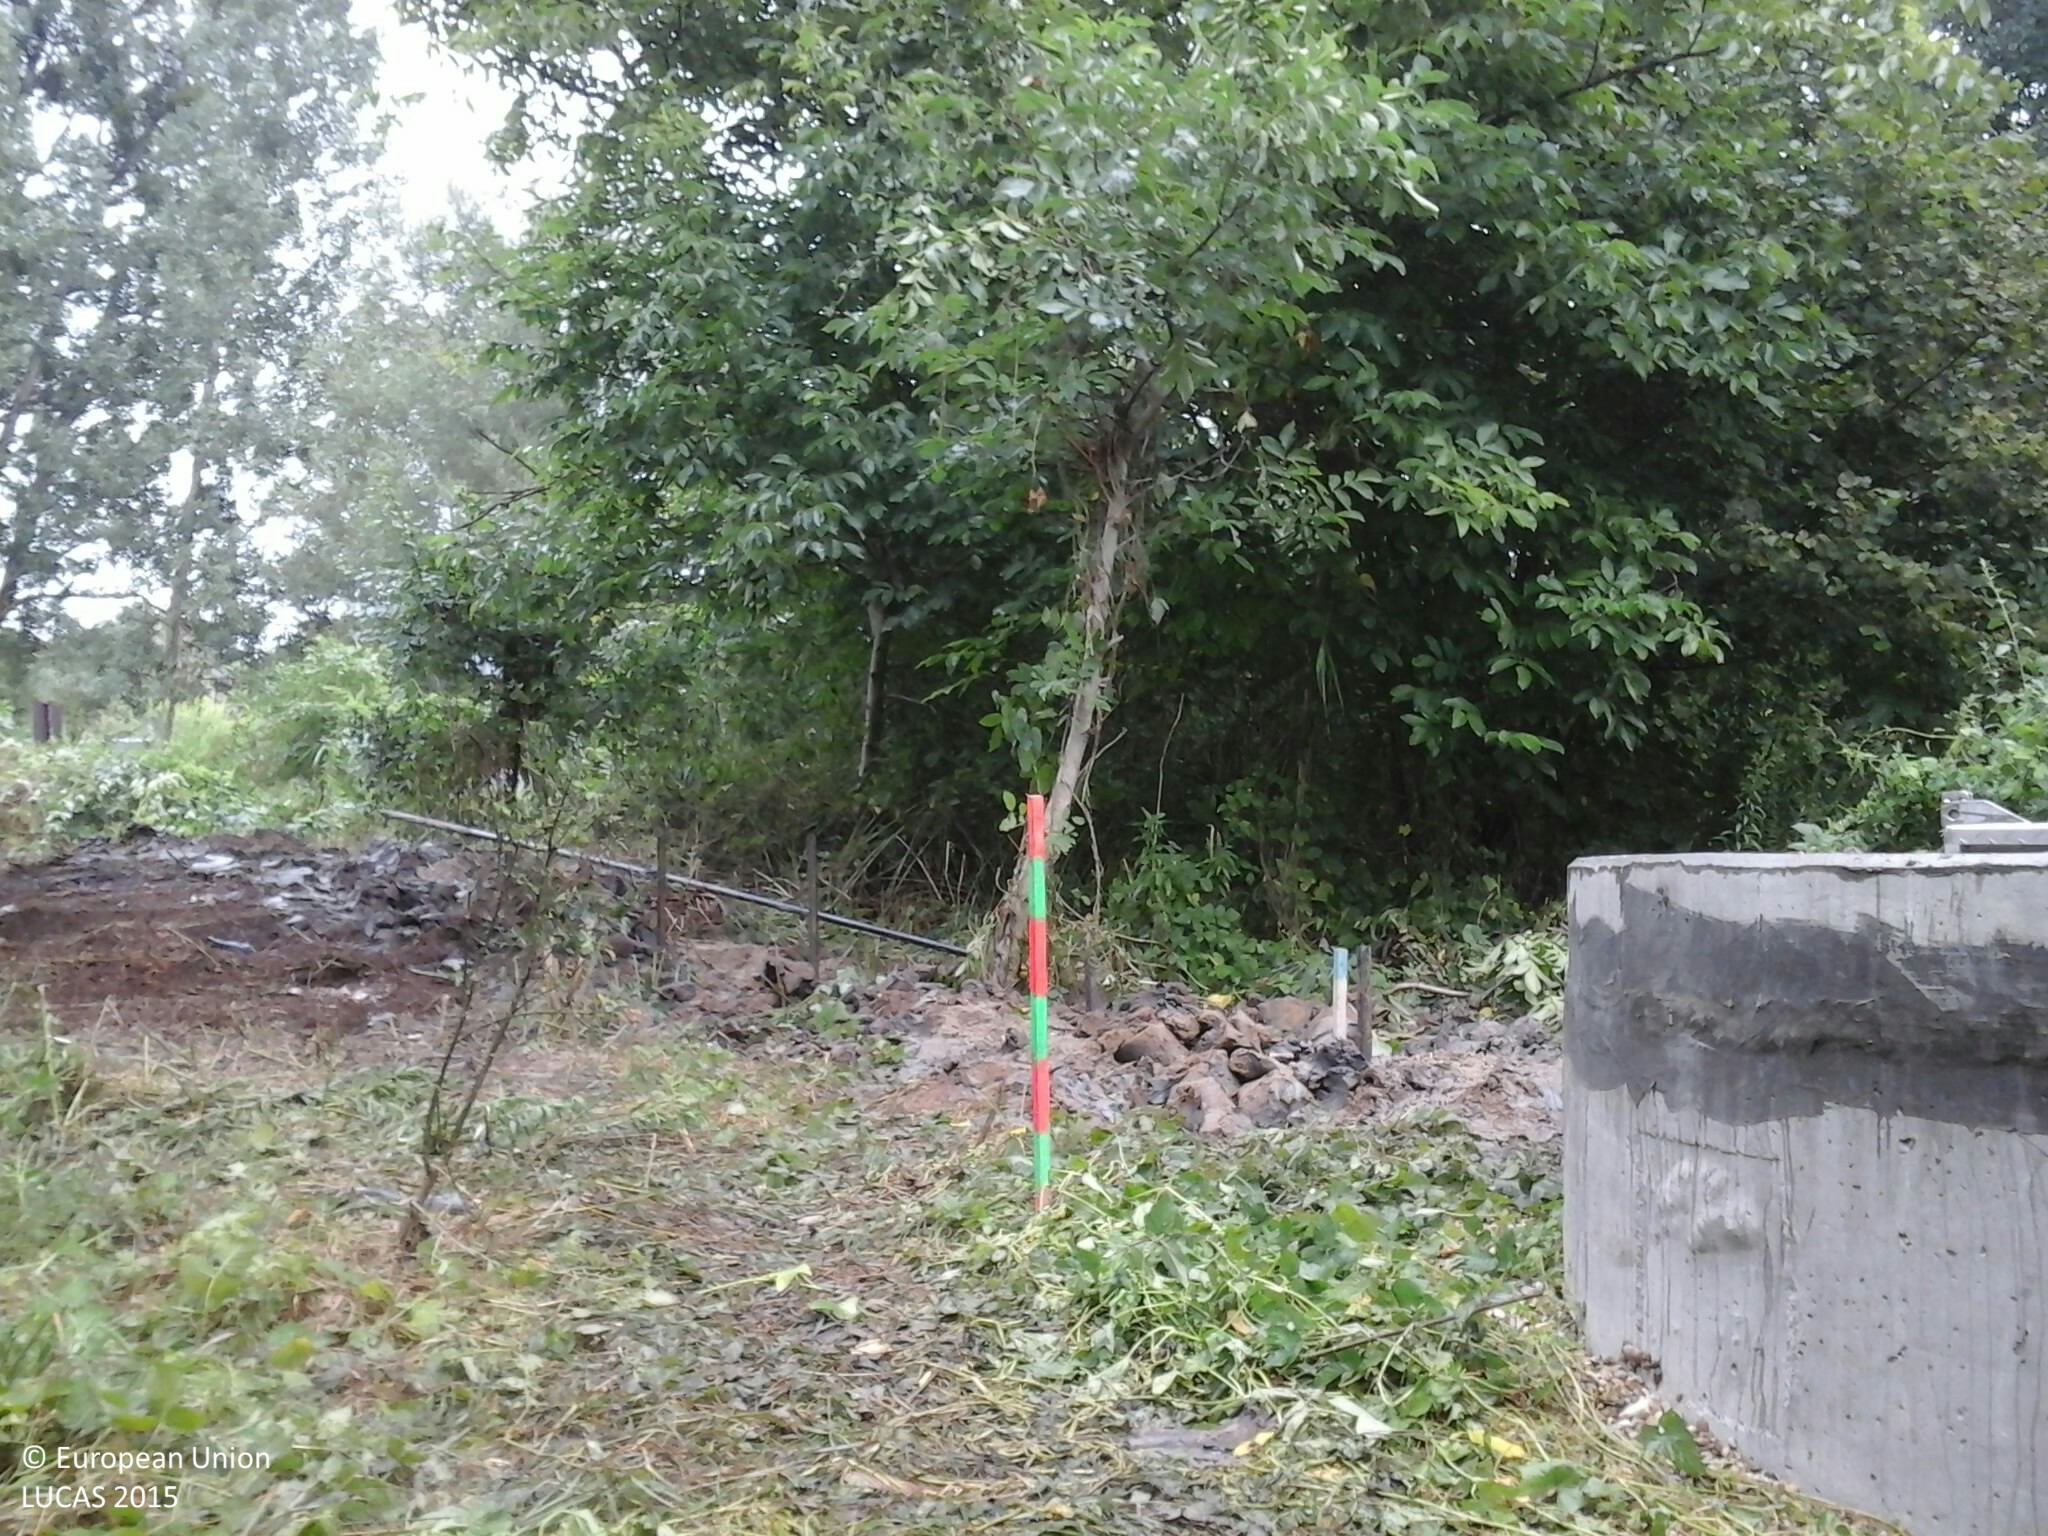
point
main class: Shrubland
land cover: Shrubland with sparse tree cover
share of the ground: > 75 %
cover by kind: shrubs 50 %, herbaceous plants 45 %, broadleaved forest trees 5 %
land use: Abandoned areas
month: July
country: HU
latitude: 46.7500
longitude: 17.8486
